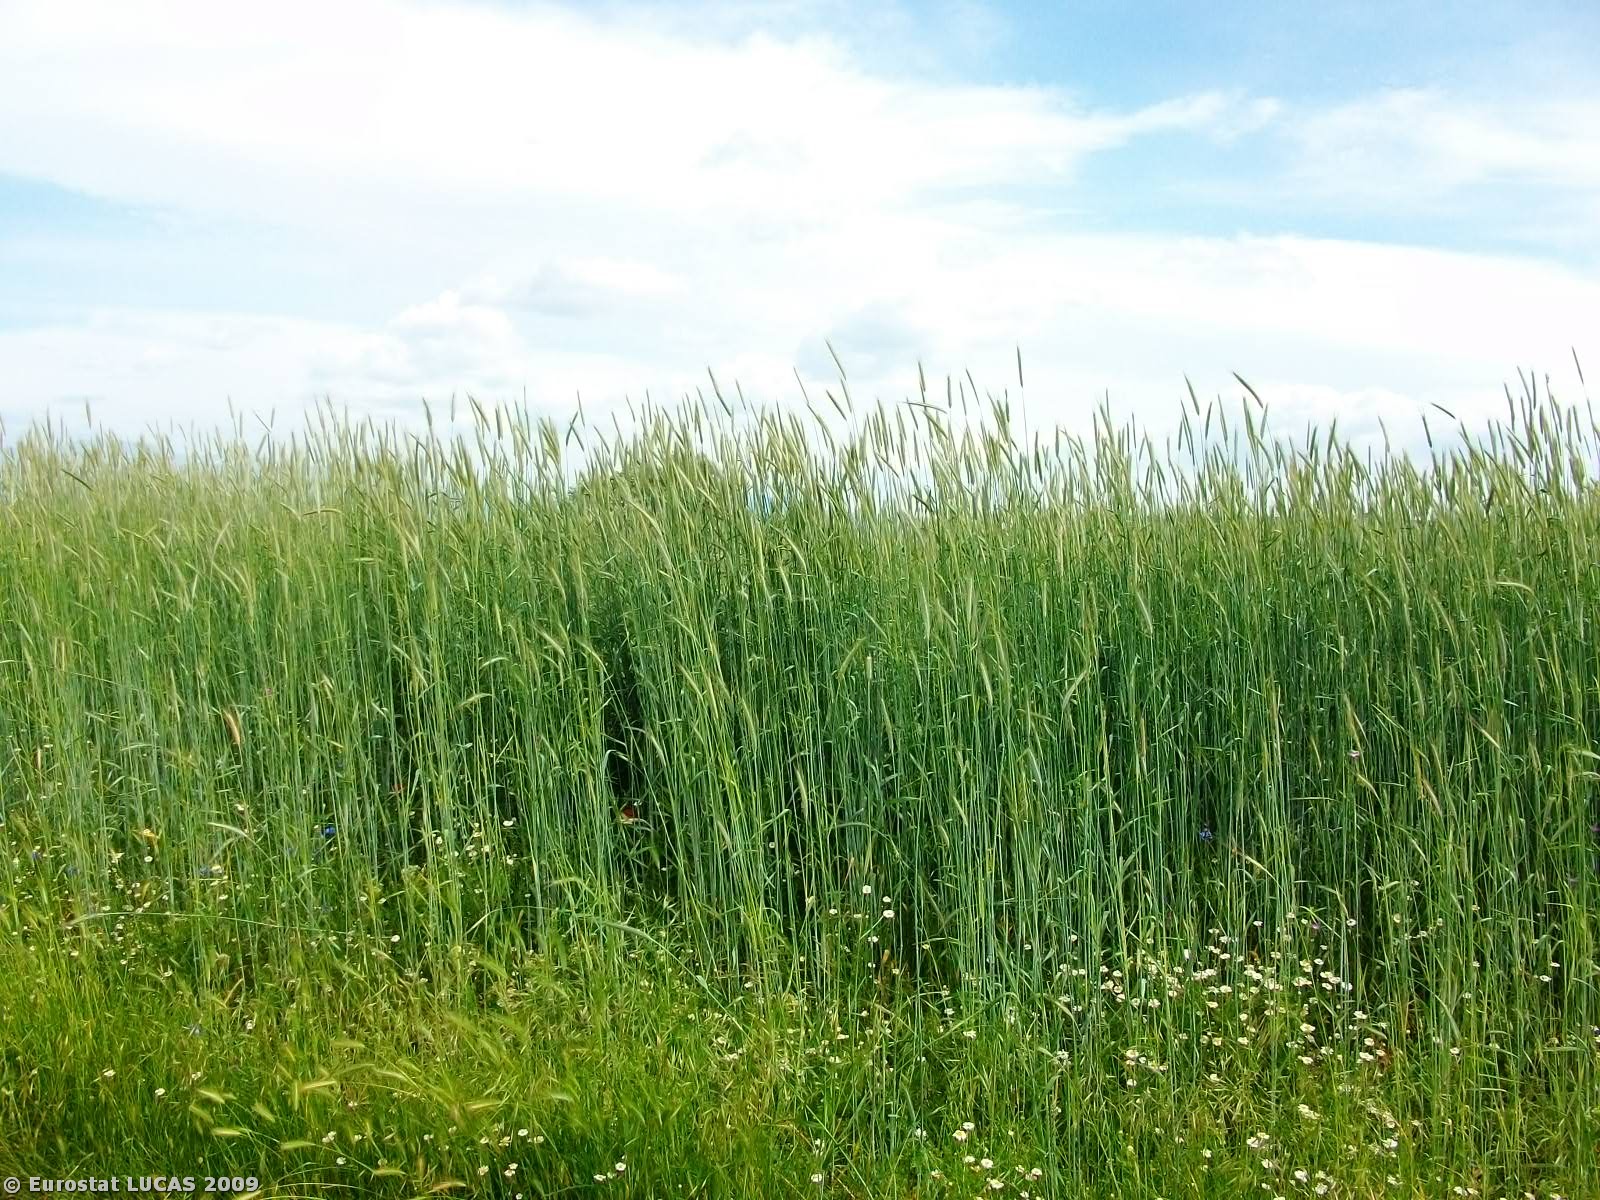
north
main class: Cropland
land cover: Barley
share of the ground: > 75 %
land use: Agriculture (excluding fallow land and kitchen gardens)
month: May
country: GR
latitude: 40.7128
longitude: 21.8697
